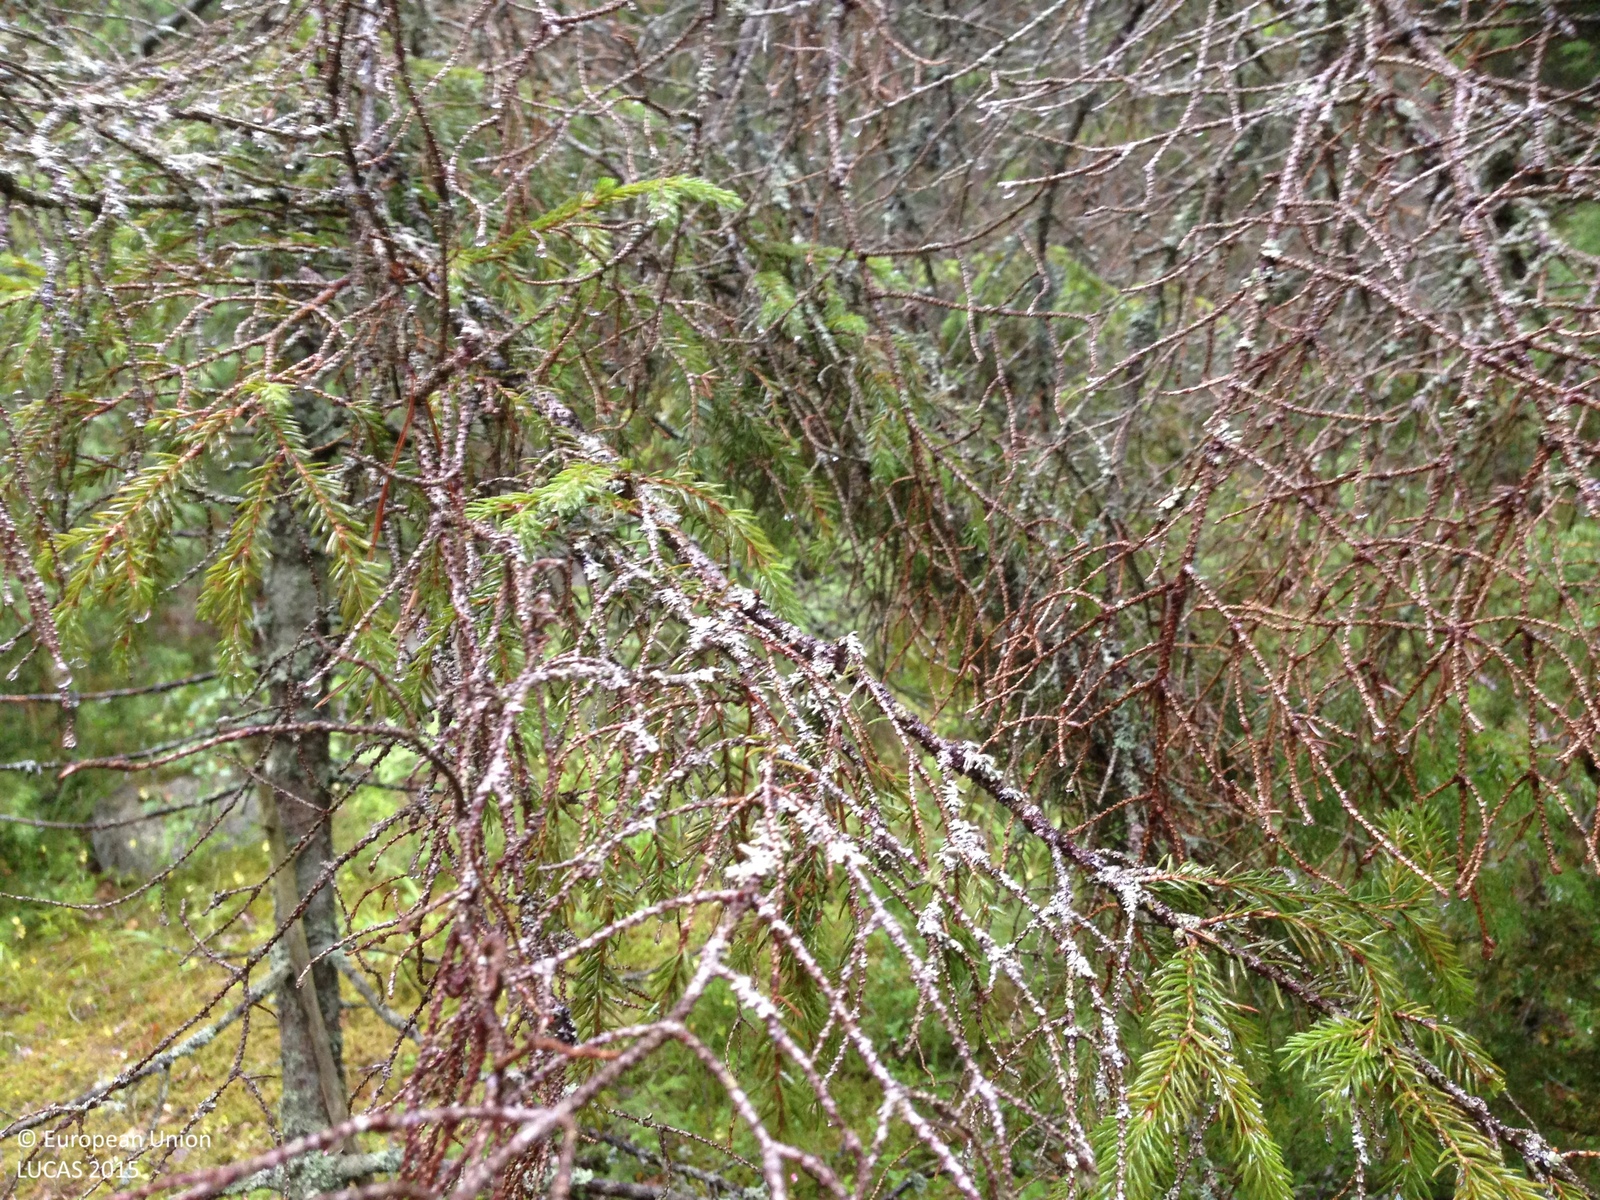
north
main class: Woodland
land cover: Spruce dominated coniferous woodland
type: boreal forest
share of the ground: > 75 %
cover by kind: coniferous forest trees 70 %, shrubs 15 %, lichens and mosses 10 %, broadleaved forest trees 5 %
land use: Forestry
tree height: > 5 m
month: July
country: SE
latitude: 59.9577
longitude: 18.5399
